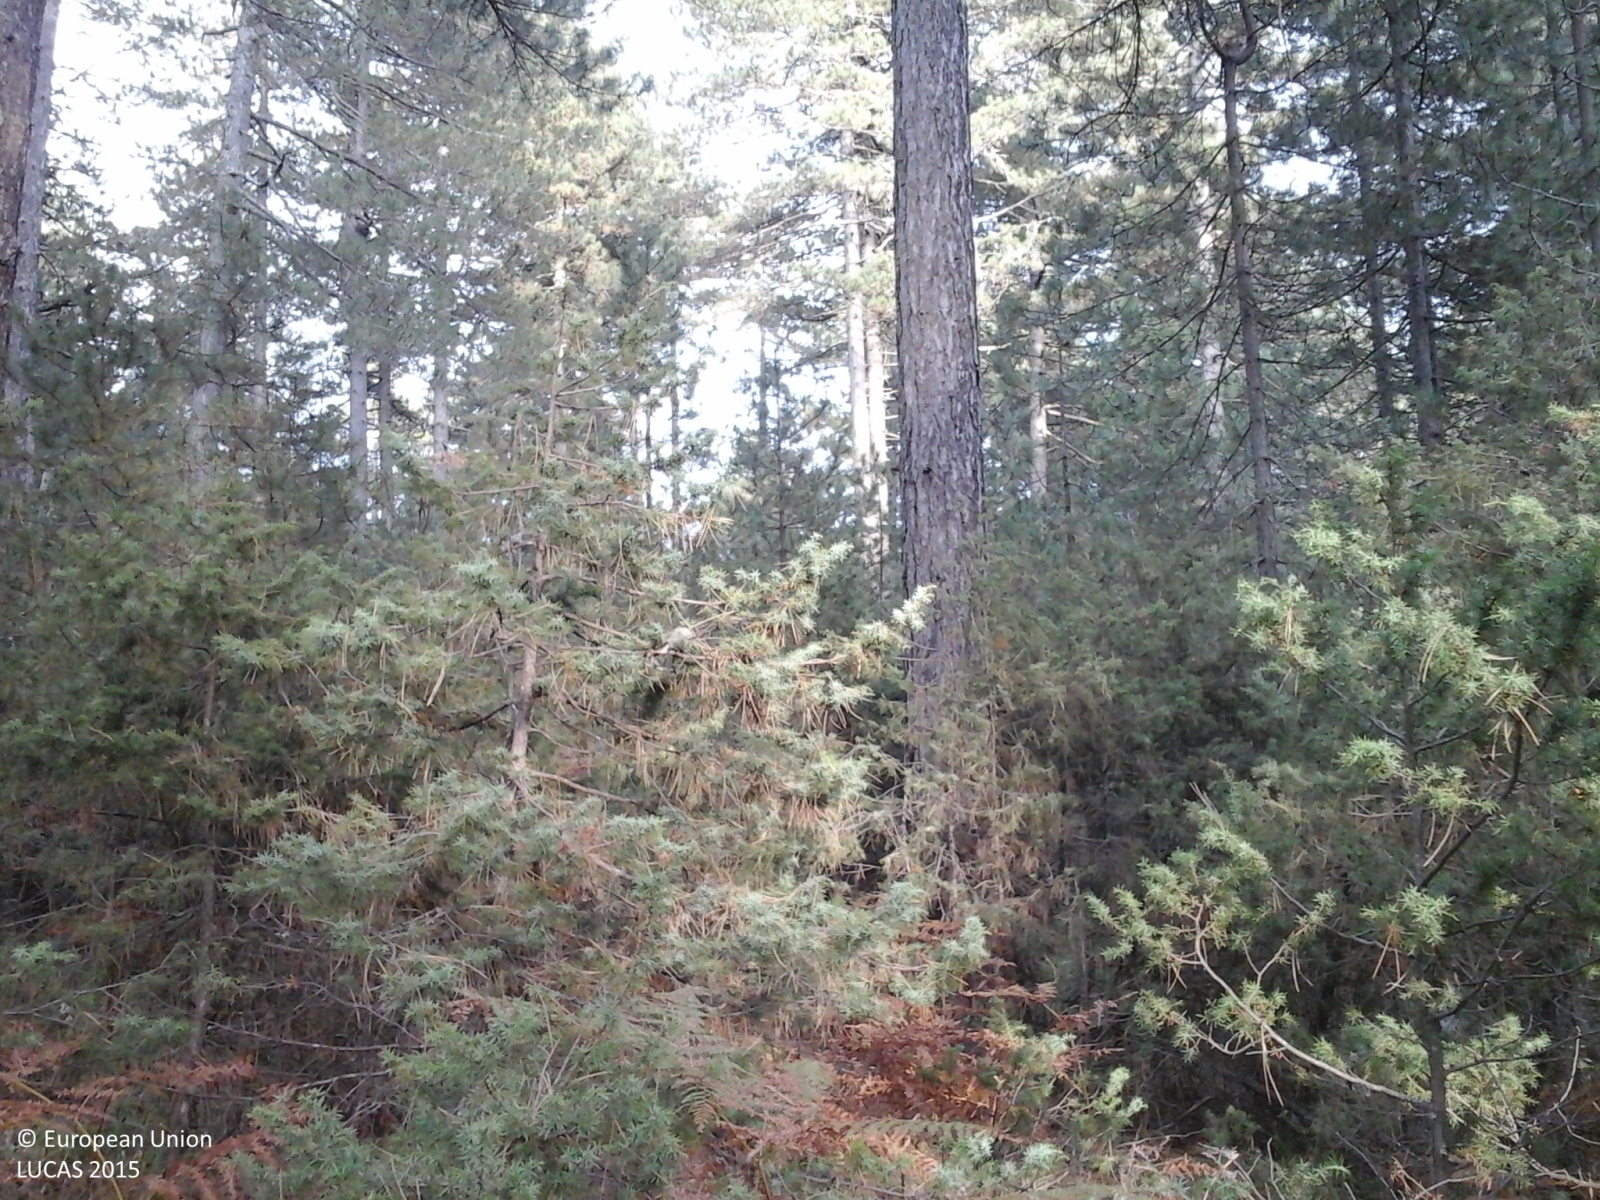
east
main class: Woodland
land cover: Pine dominated coniferous woodland
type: coniferous forest of the mediterranean region
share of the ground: 50 - 75 %
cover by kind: coniferous forest trees 70 %, herbaceous plants 20 %, shrubs 5 %, unconsolidated bare surface 5 %
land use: Forestry
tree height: > 5 m
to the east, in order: Pine dominated coniferous woodland; Tracks; Pine dominated coniferous woodland
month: October
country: GR
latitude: 39.8473
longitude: 21.0024
